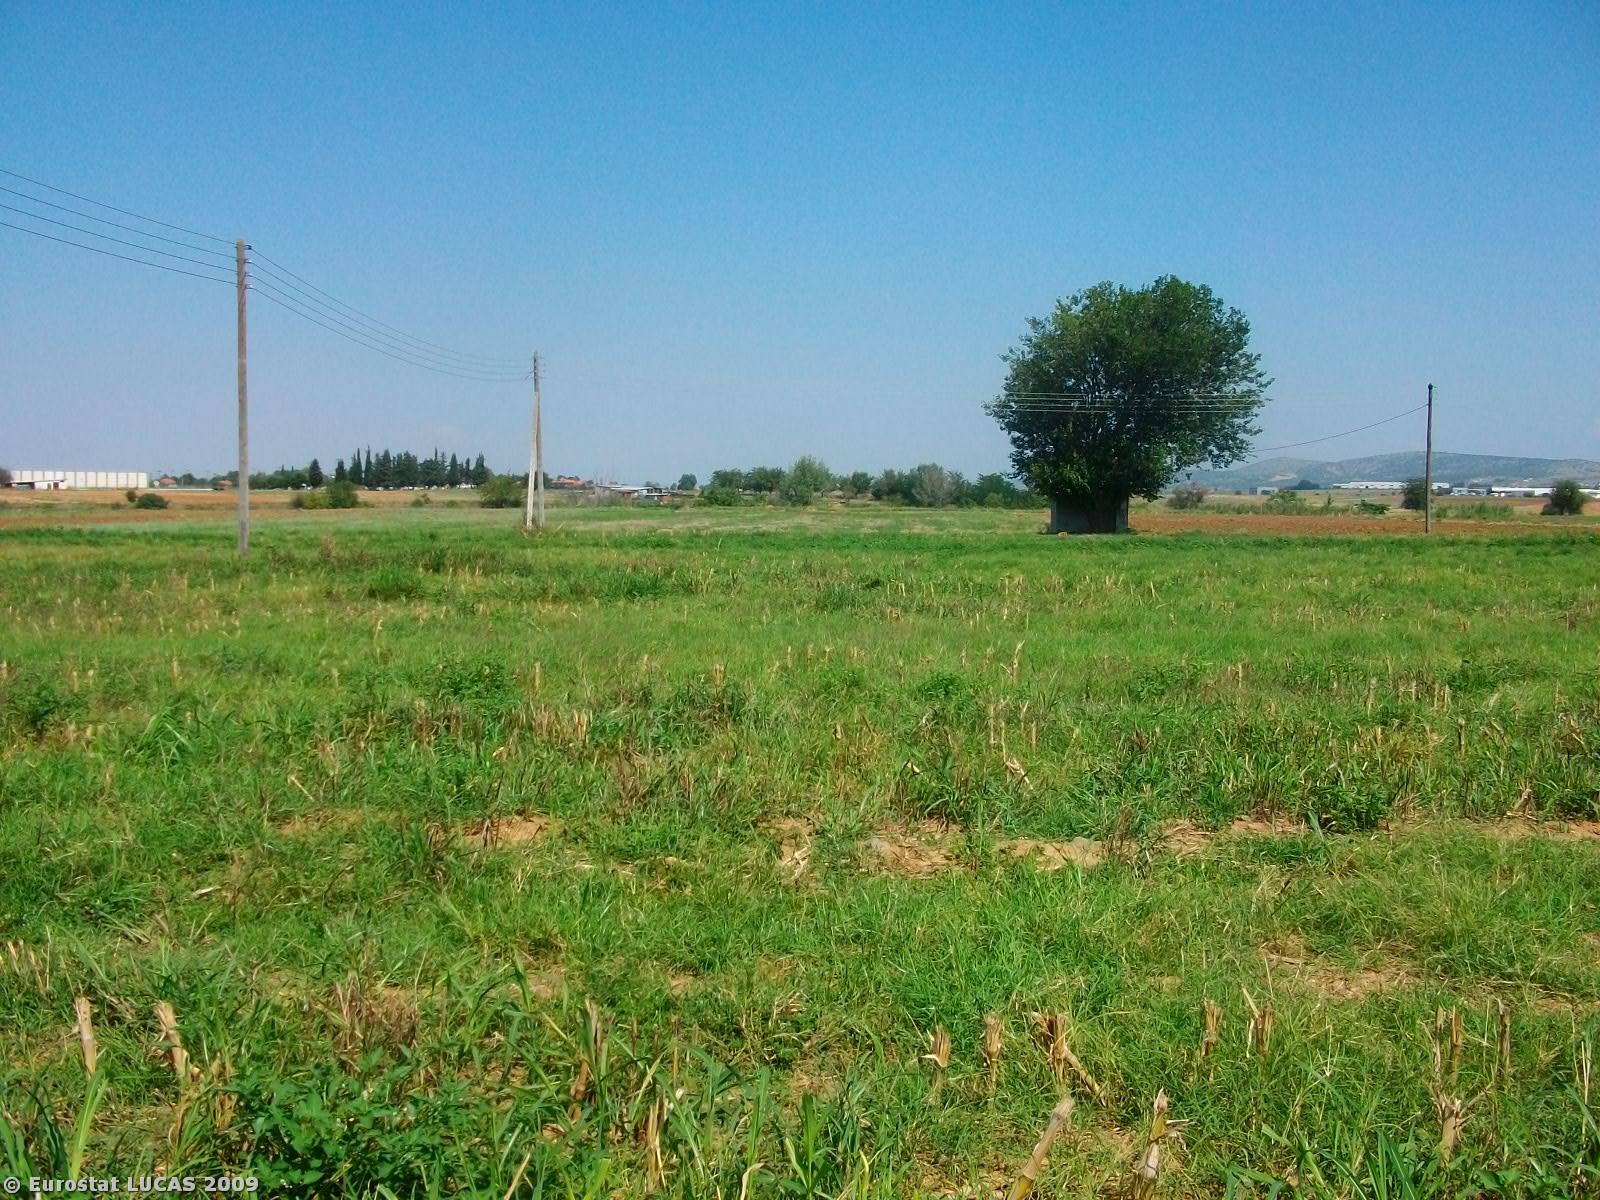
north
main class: Cropland
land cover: Maize
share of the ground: < 10 %
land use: Agriculture (excluding fallow land and kitchen gardens)
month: August
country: GR
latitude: 40.8207
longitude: 22.8967
